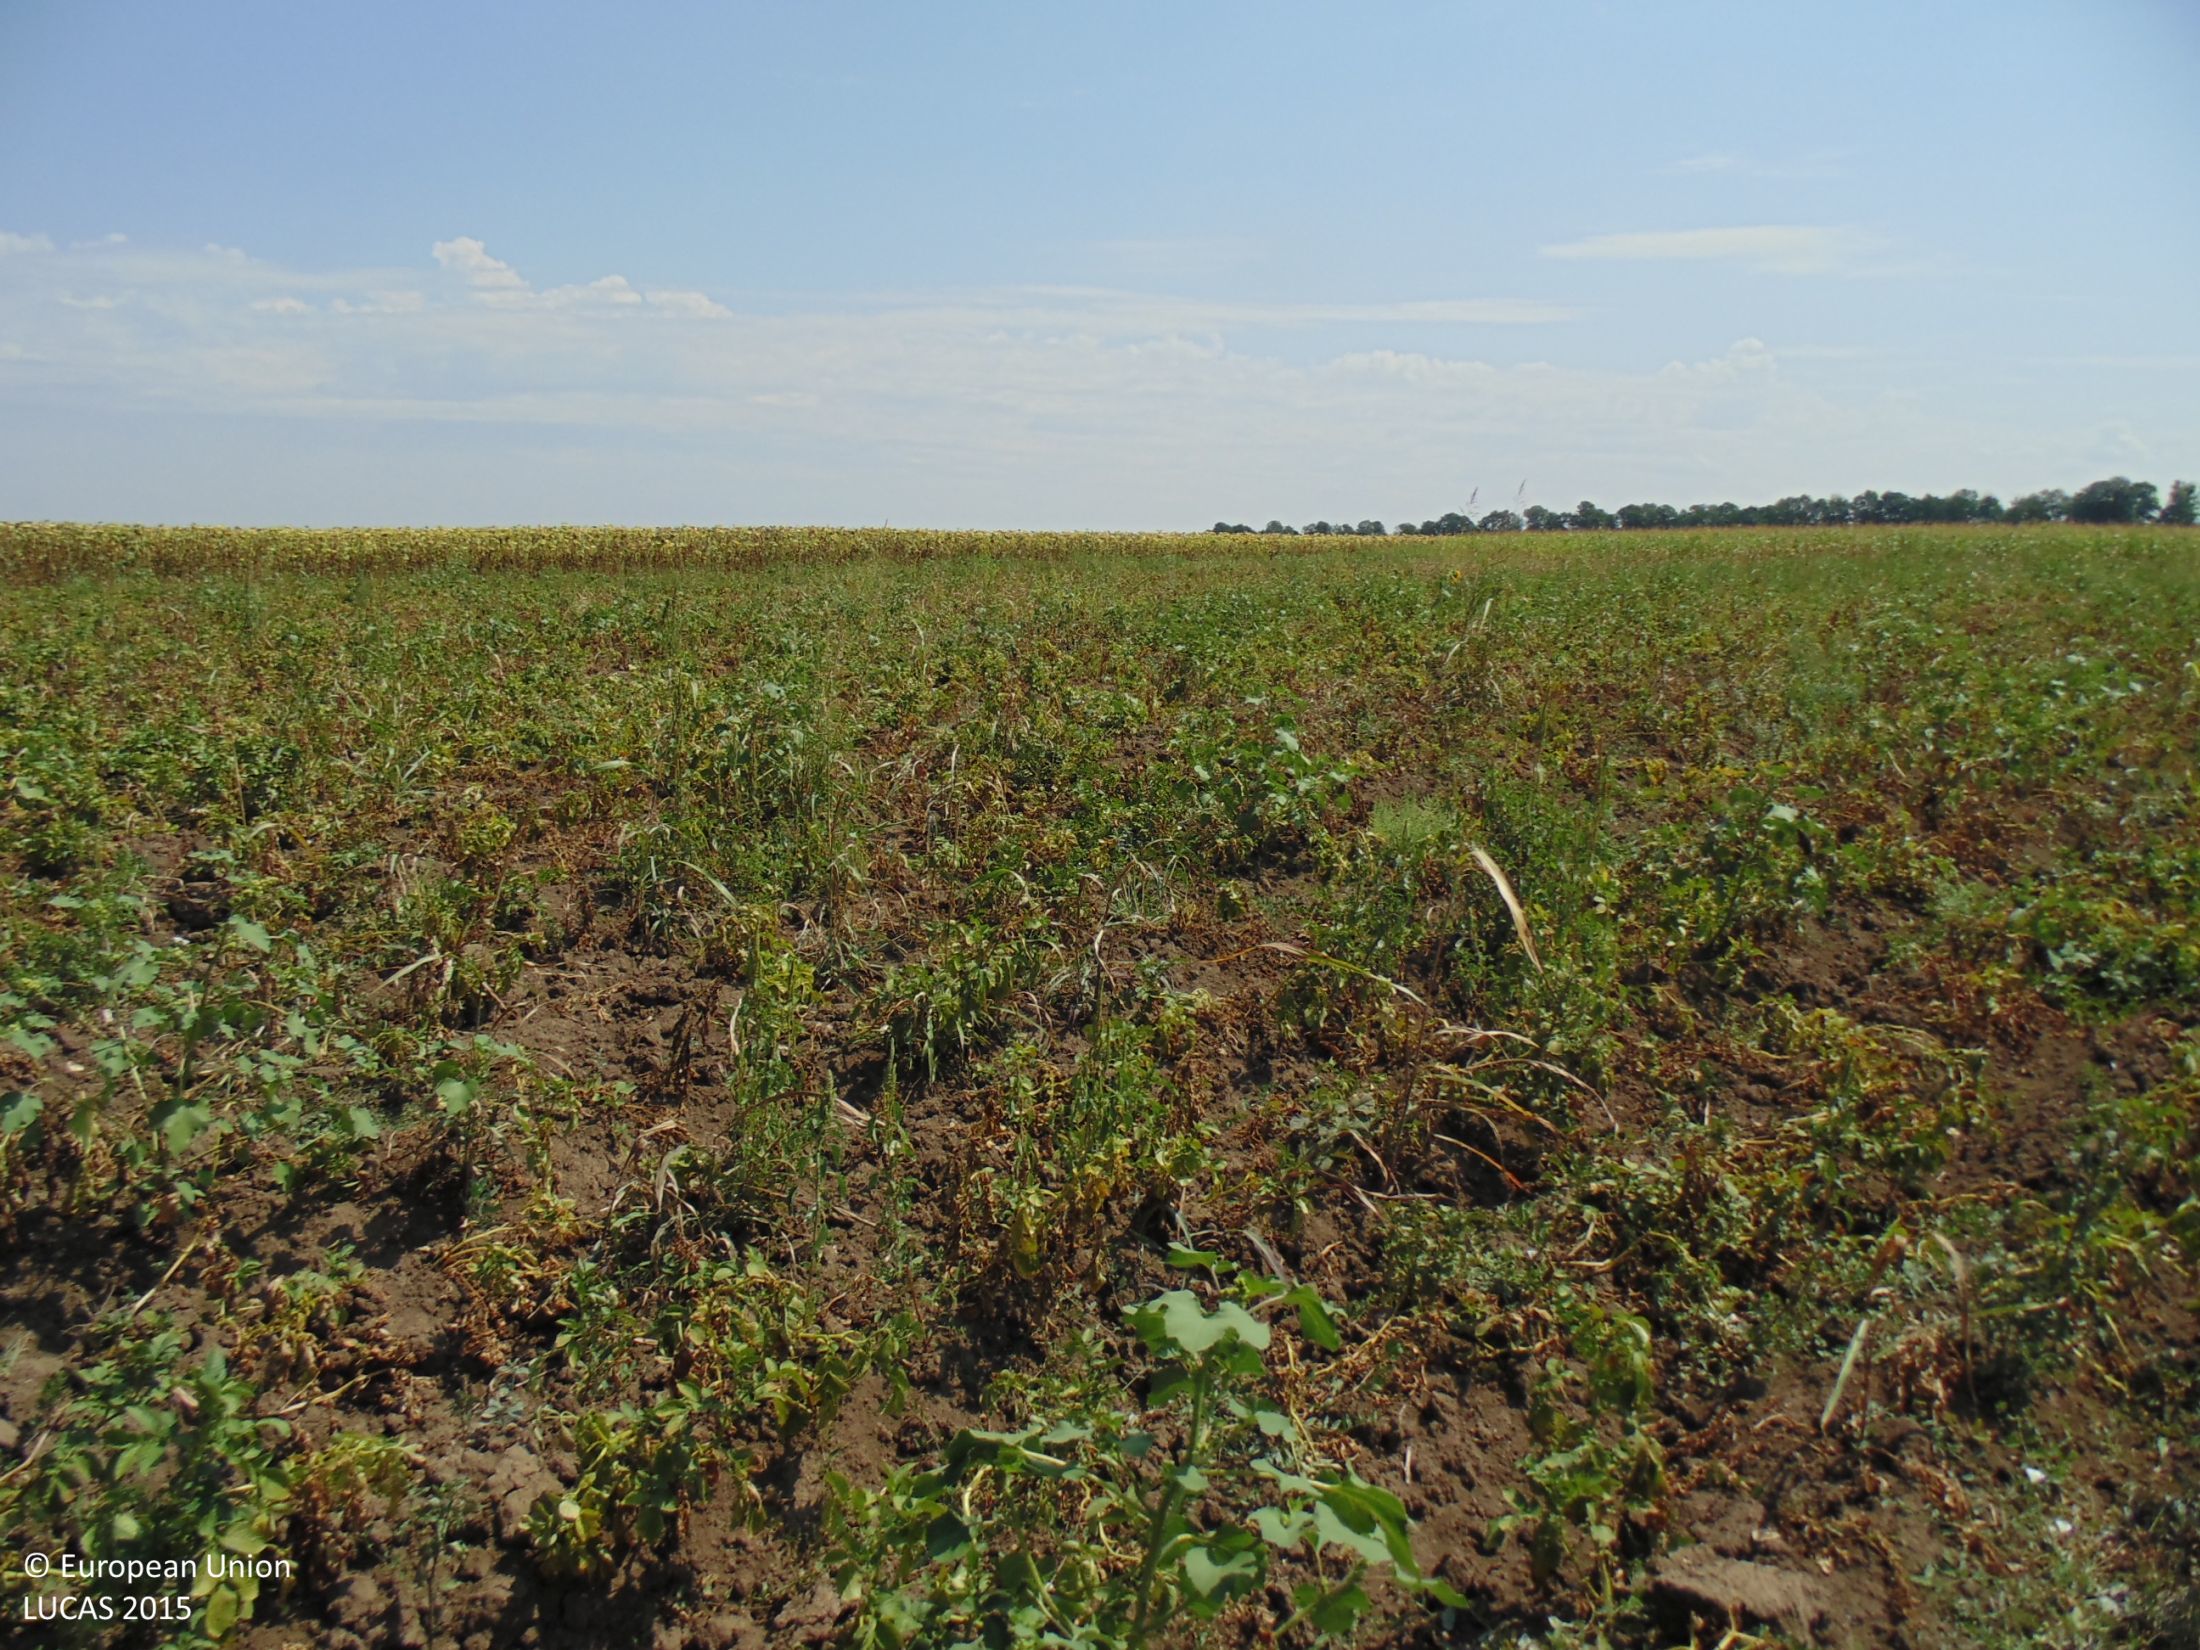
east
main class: Cropland
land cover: Potatoes
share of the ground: > 75 %
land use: Agriculture (excluding fallow land and kitchen gardens)
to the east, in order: Potatoes; Grass margins; Sunflower
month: August
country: BG
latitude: 43.7120
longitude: 27.6243
